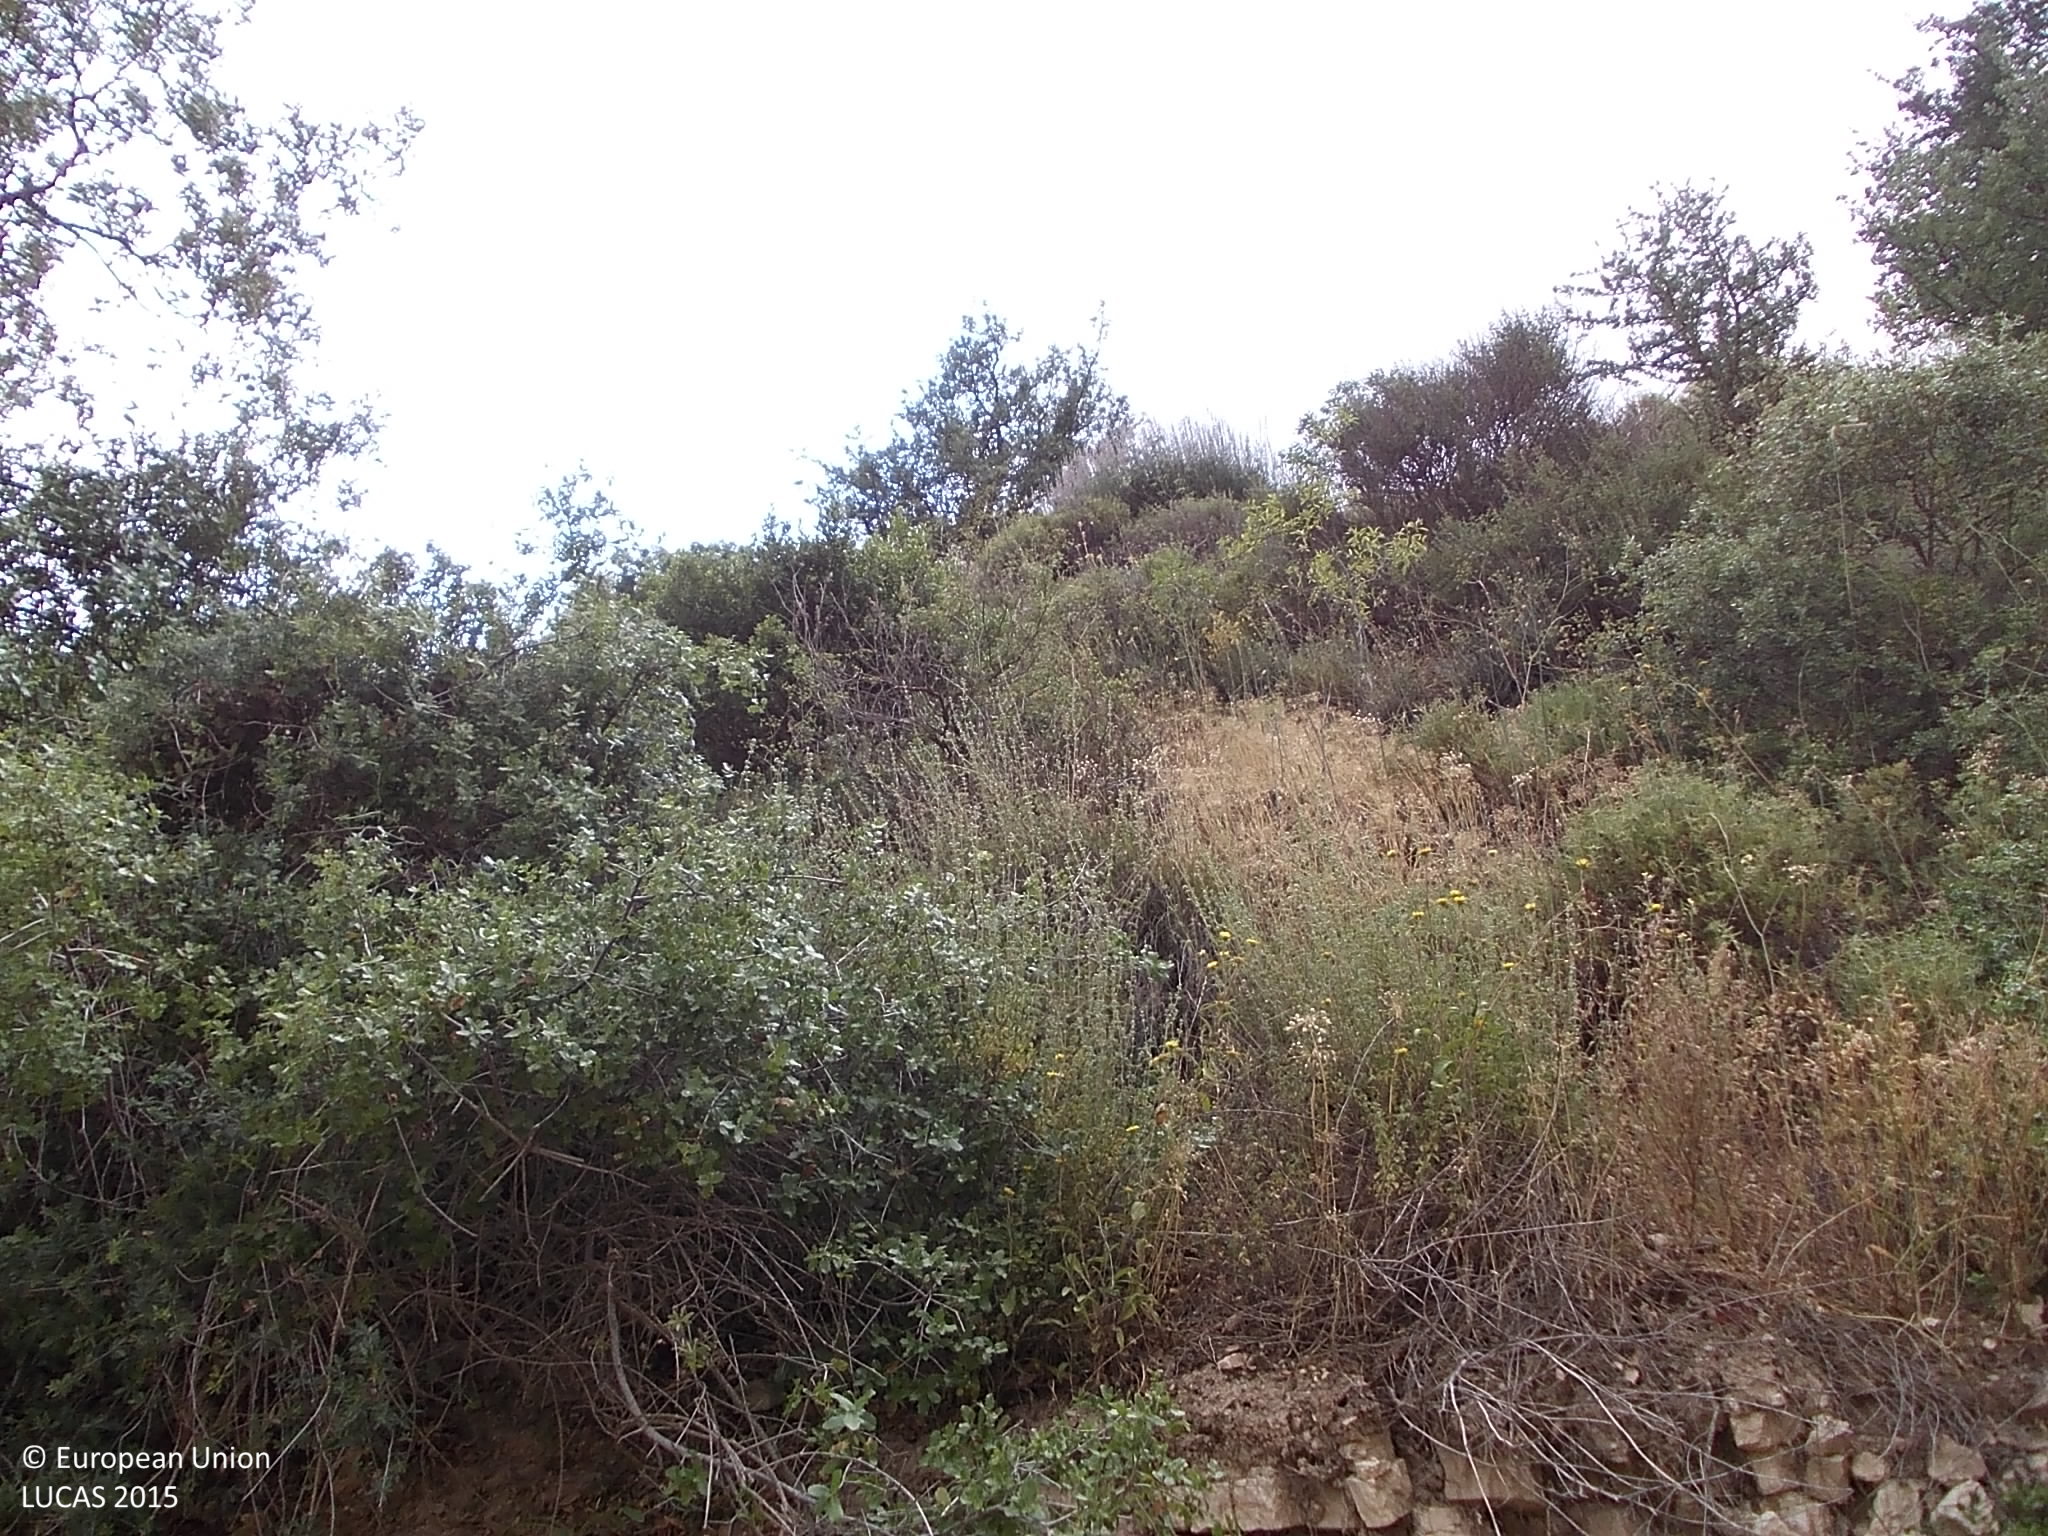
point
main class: Woodland
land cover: Broadleaved woodland
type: broadleaved evergreen forest
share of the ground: 10 - 25 %
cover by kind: shrubs 65 %, broadleaved forest trees 15 %, herbaceous plants 10 %, unconsolidated bare surface 10 %
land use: Semi-natural and natural areas not in use
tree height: > 5 m
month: May
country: CY
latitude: 34.8252
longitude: 32.8039
